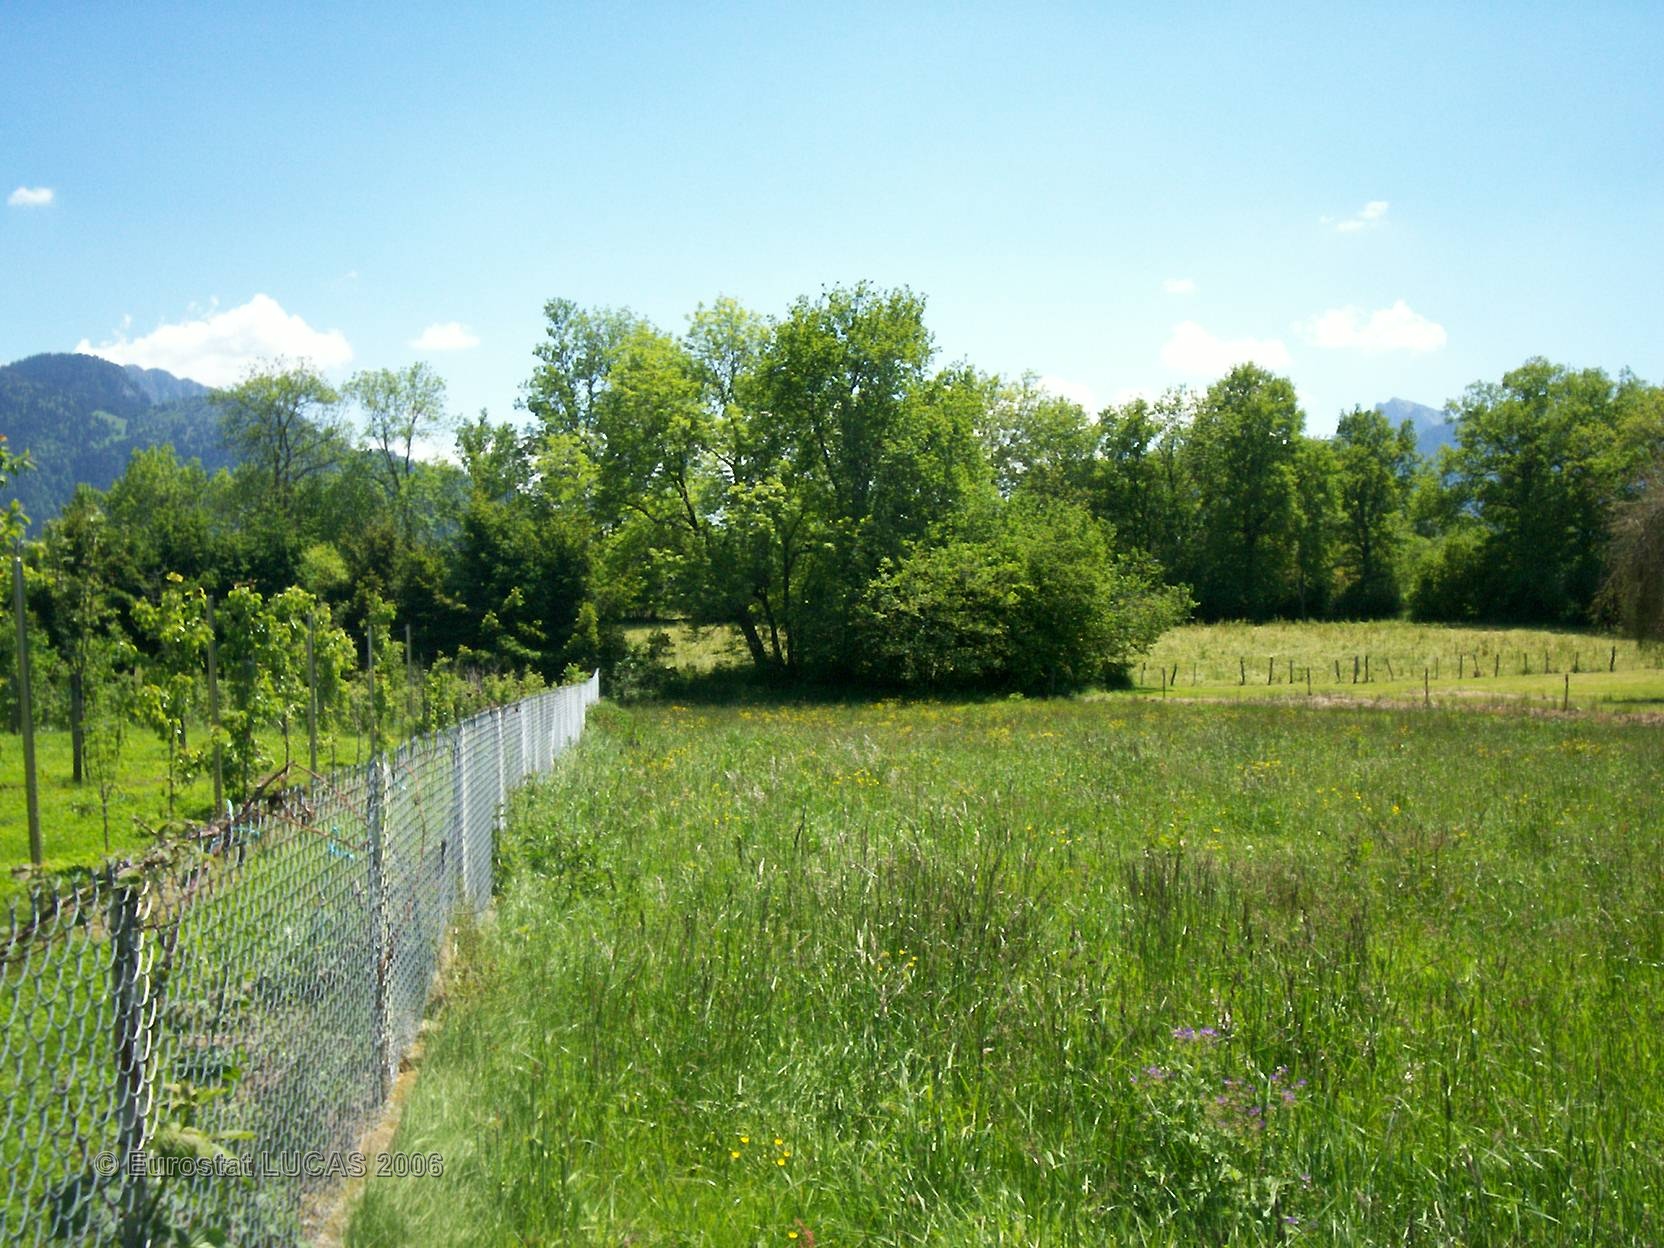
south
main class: Grassland
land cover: Grassland with sparse tree/shrub cover
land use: Residential
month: June
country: FR
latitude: 46.3516
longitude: 6.6115
